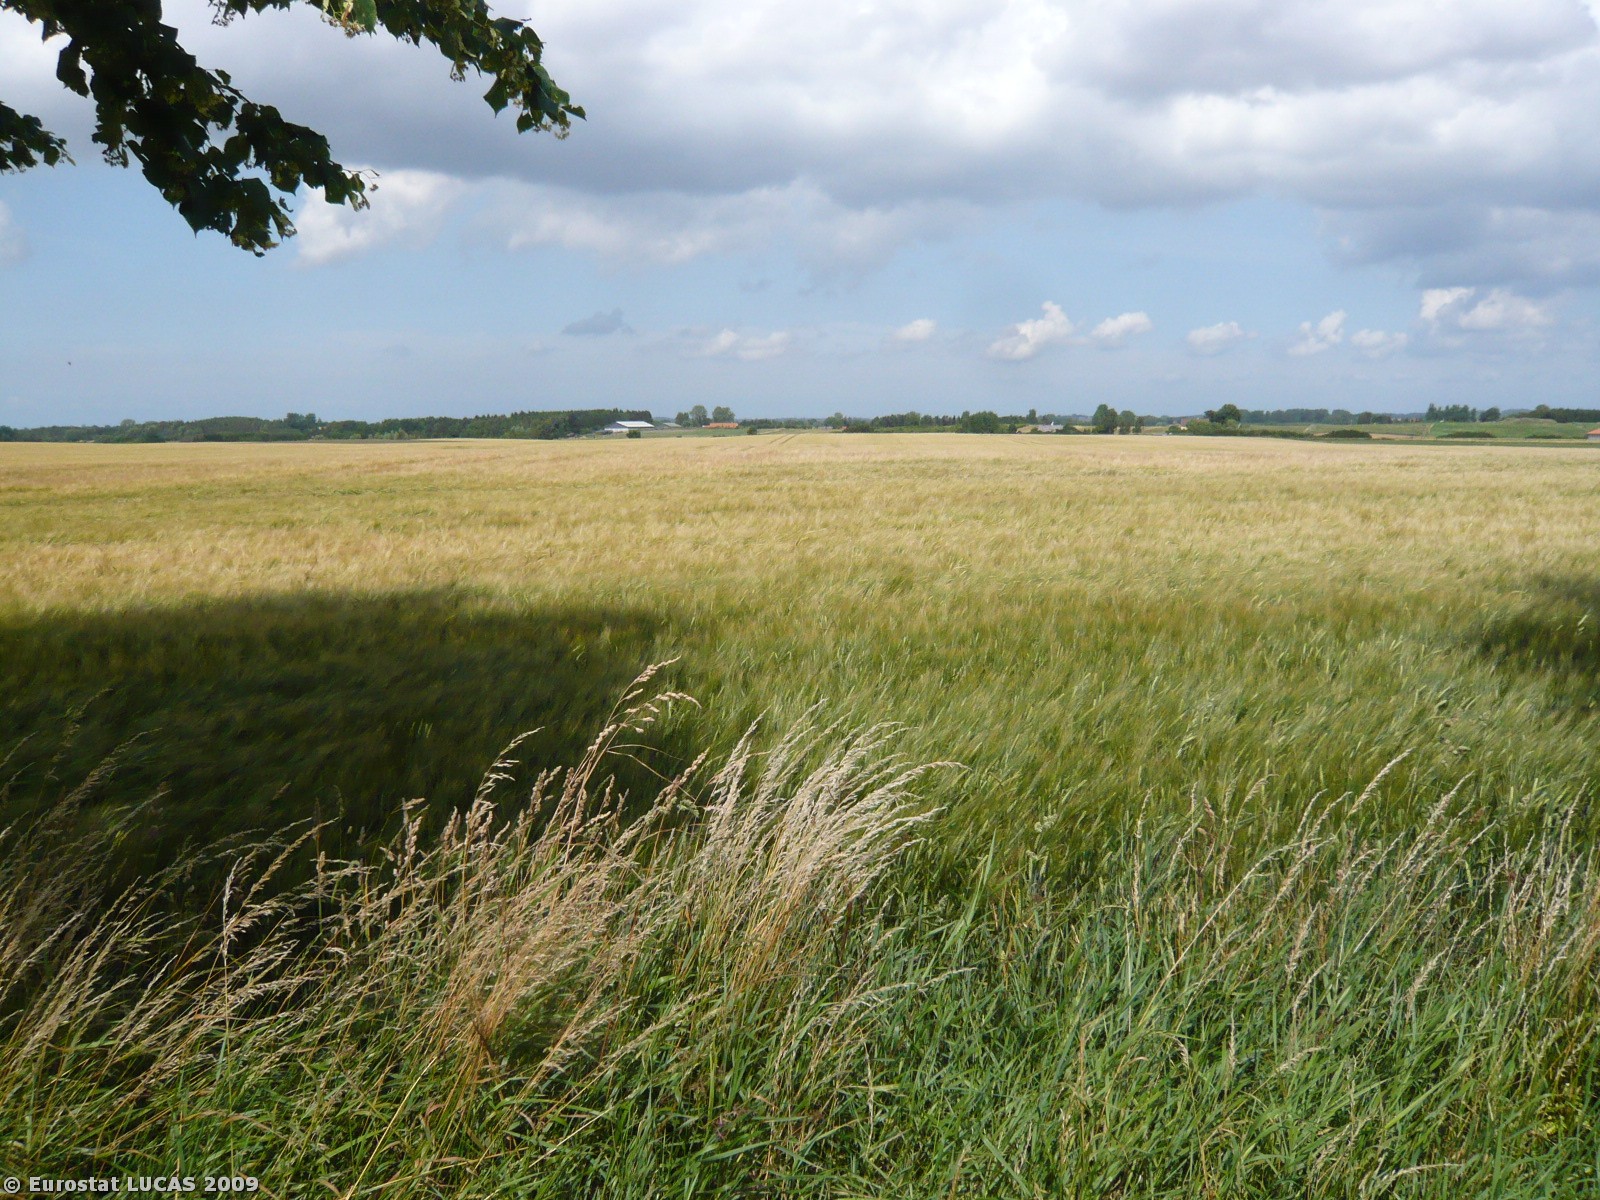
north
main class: Cropland
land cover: Barley
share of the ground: > 75 %
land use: Agriculture (excluding fallow land and kitchen gardens)
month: July
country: DK
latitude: 55.6923
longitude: 11.6052
